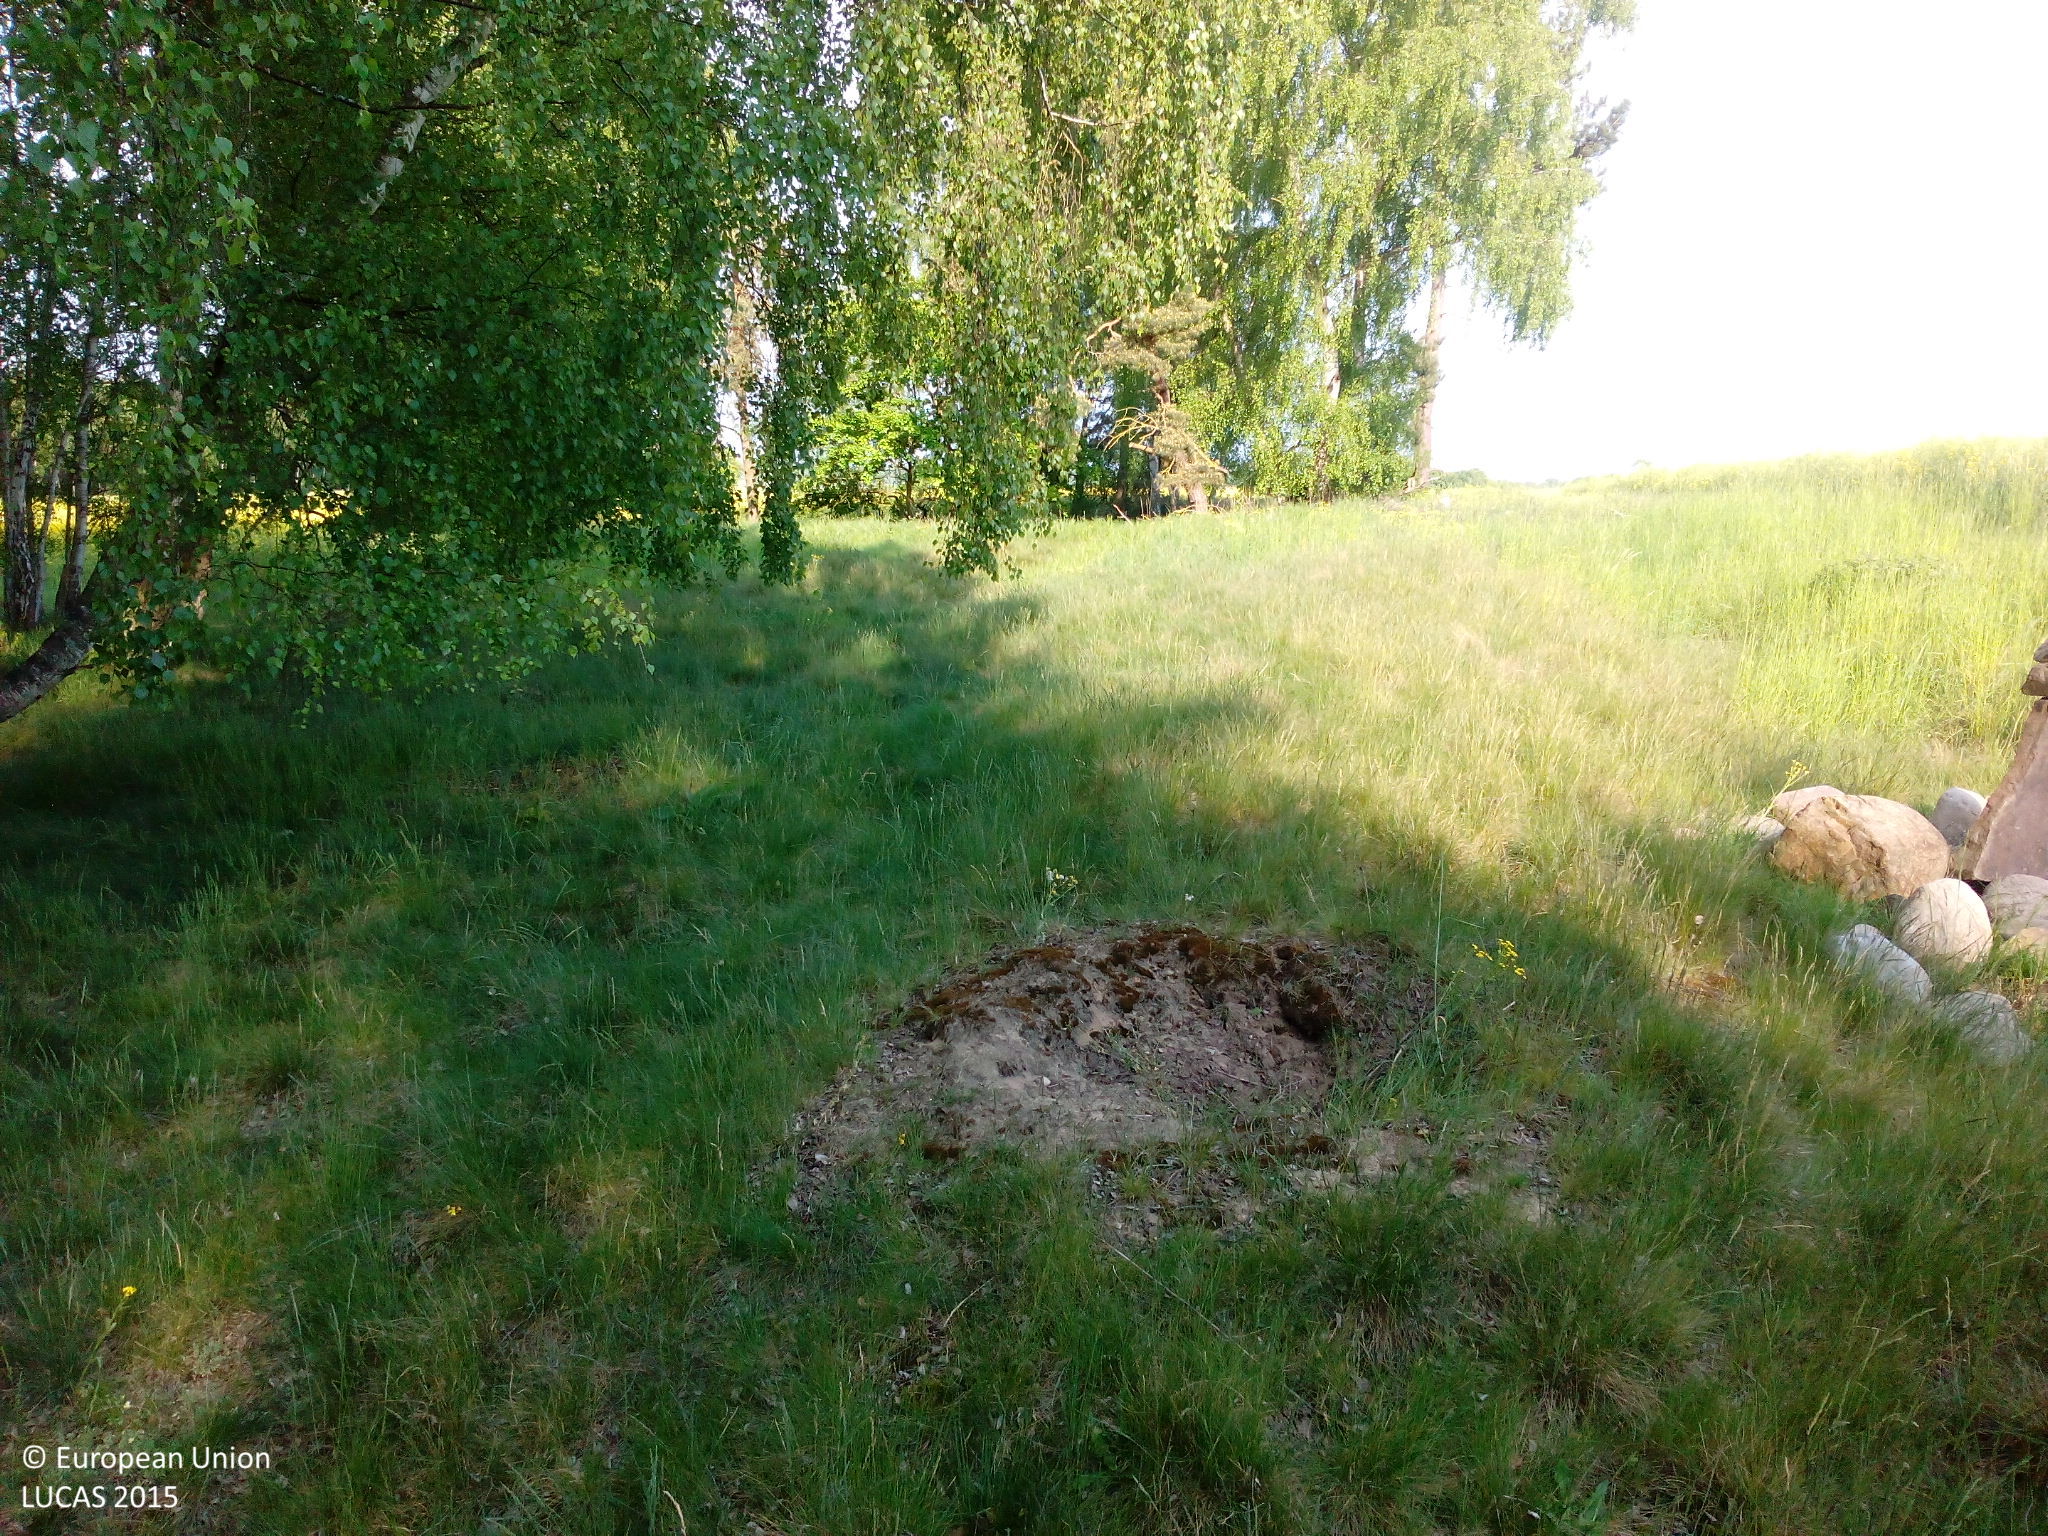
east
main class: Grassland
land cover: Grassland without tree/shrub cover
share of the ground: > 75 %
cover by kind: herbaceous plants 90 %, unconsolidated bare surface 10 %
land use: Agriculture (excluding fallow land and kitchen gardens)
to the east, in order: Grassland without tree/shrub cover; Broadleaved woodland; Grassland without tree/shrub cover; Broadleaved woodland; Grassland without tree/shrub cover; Rape and turnip rape; Grass margins; Tracks; Grass margins; Rape and turnip rape
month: May
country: DE
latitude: 52.7315
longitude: 11.1399
